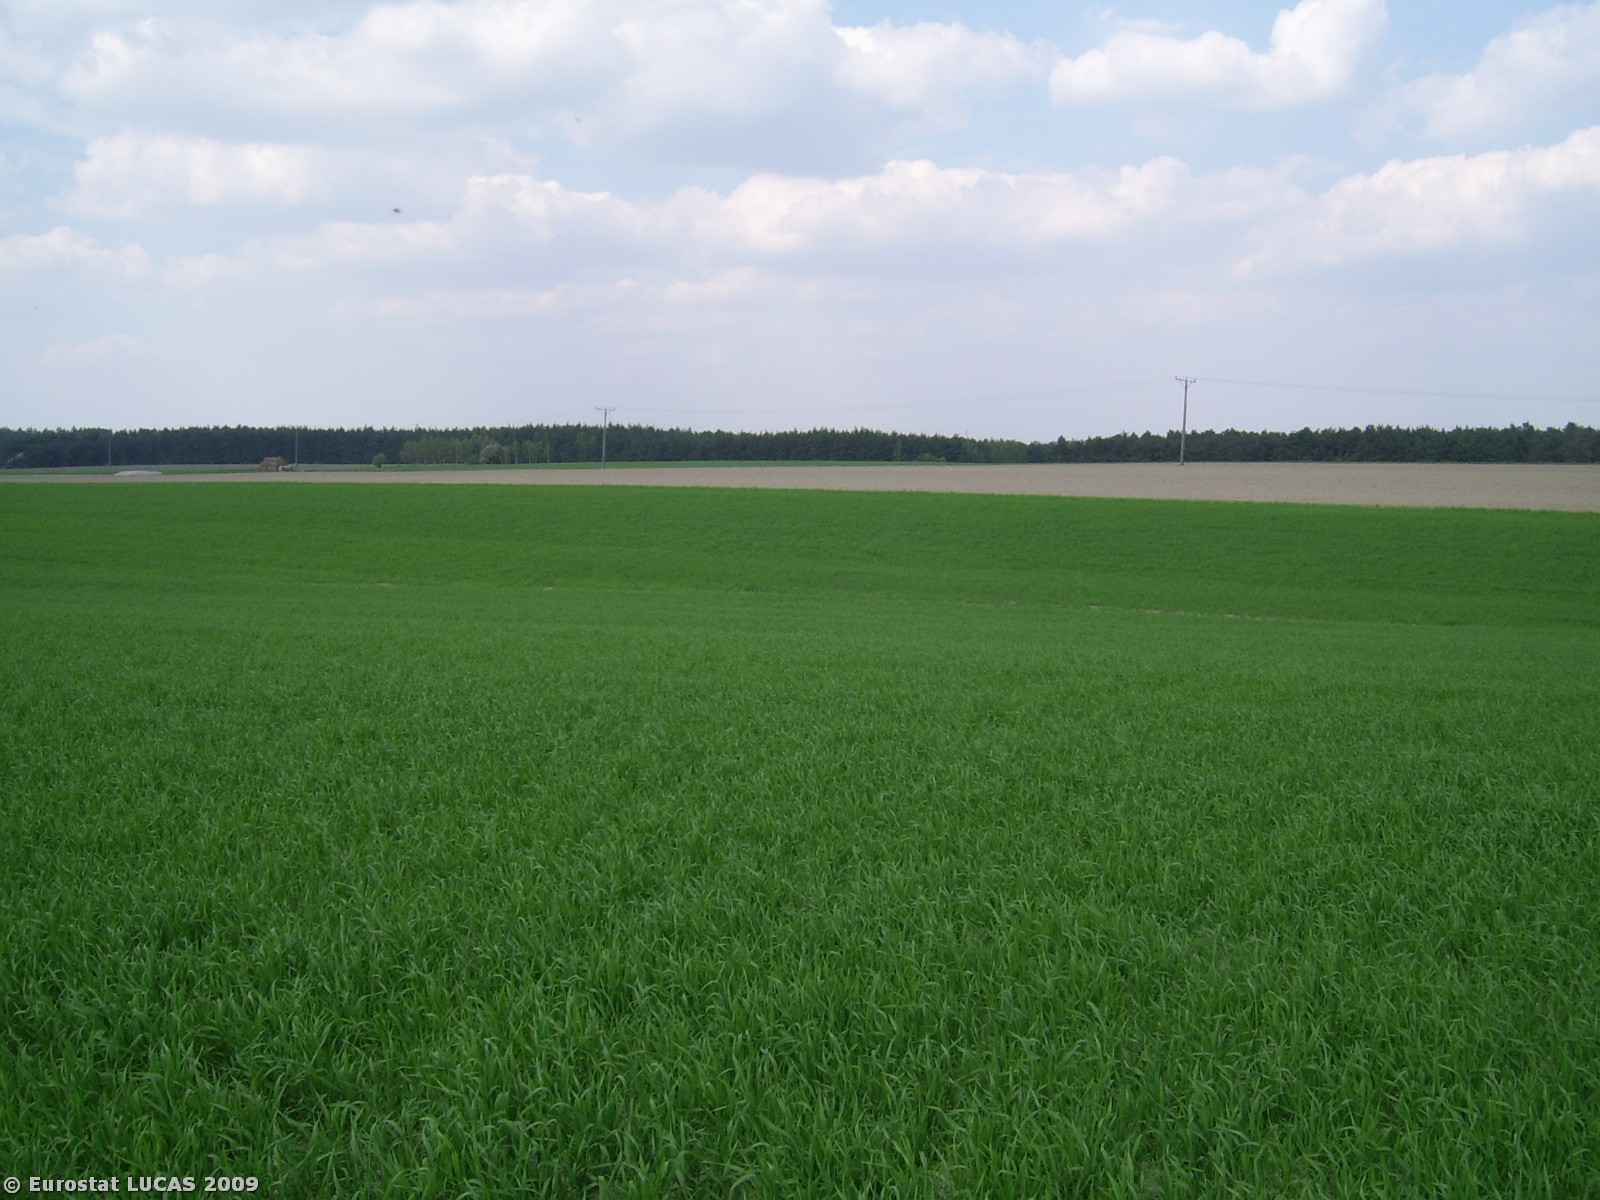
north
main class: Cropland
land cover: Rye
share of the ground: > 75 %
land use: Agriculture (excluding fallow land and kitchen gardens)
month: April
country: PL
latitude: 52.3003
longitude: 16.9458
